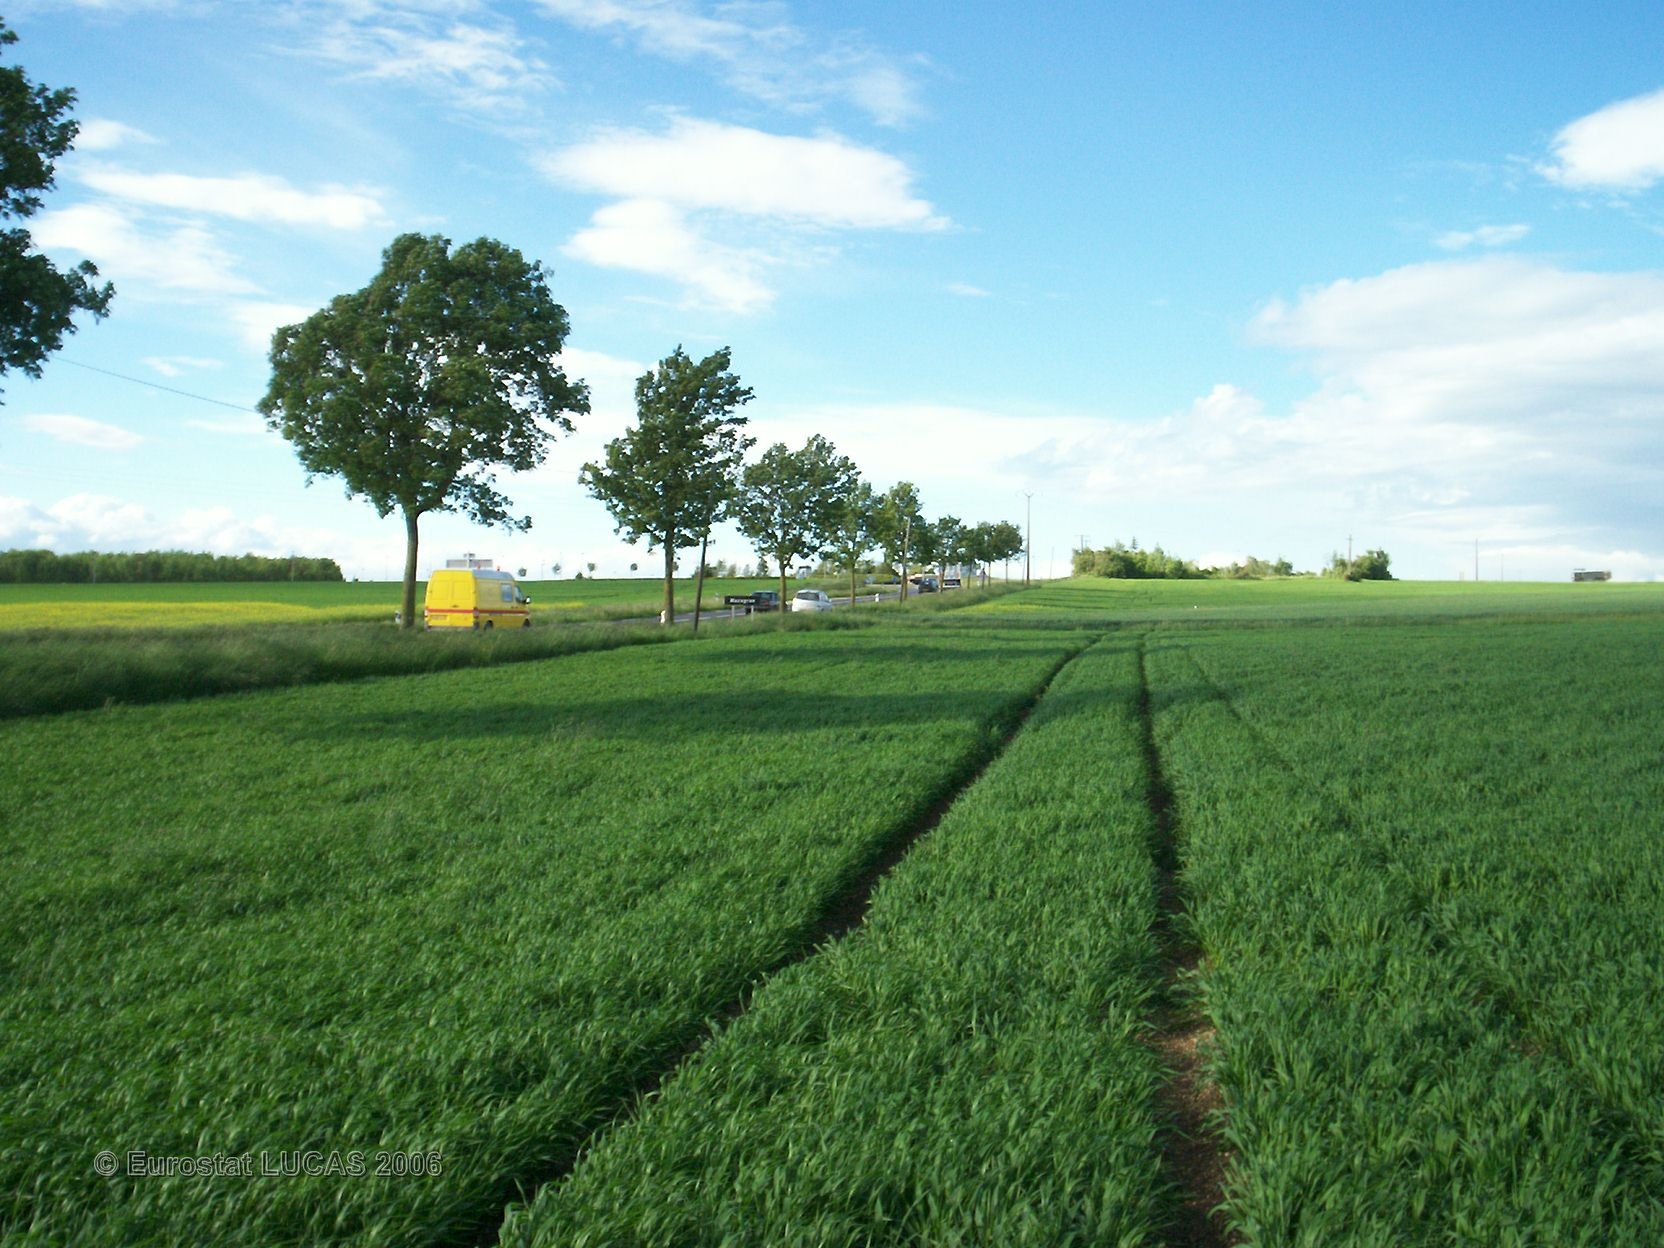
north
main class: Cropland
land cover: Barley
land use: Agriculture (excluding fallow land and kitchen gardens)
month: May
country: FR
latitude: 49.3886
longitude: 4.5823
